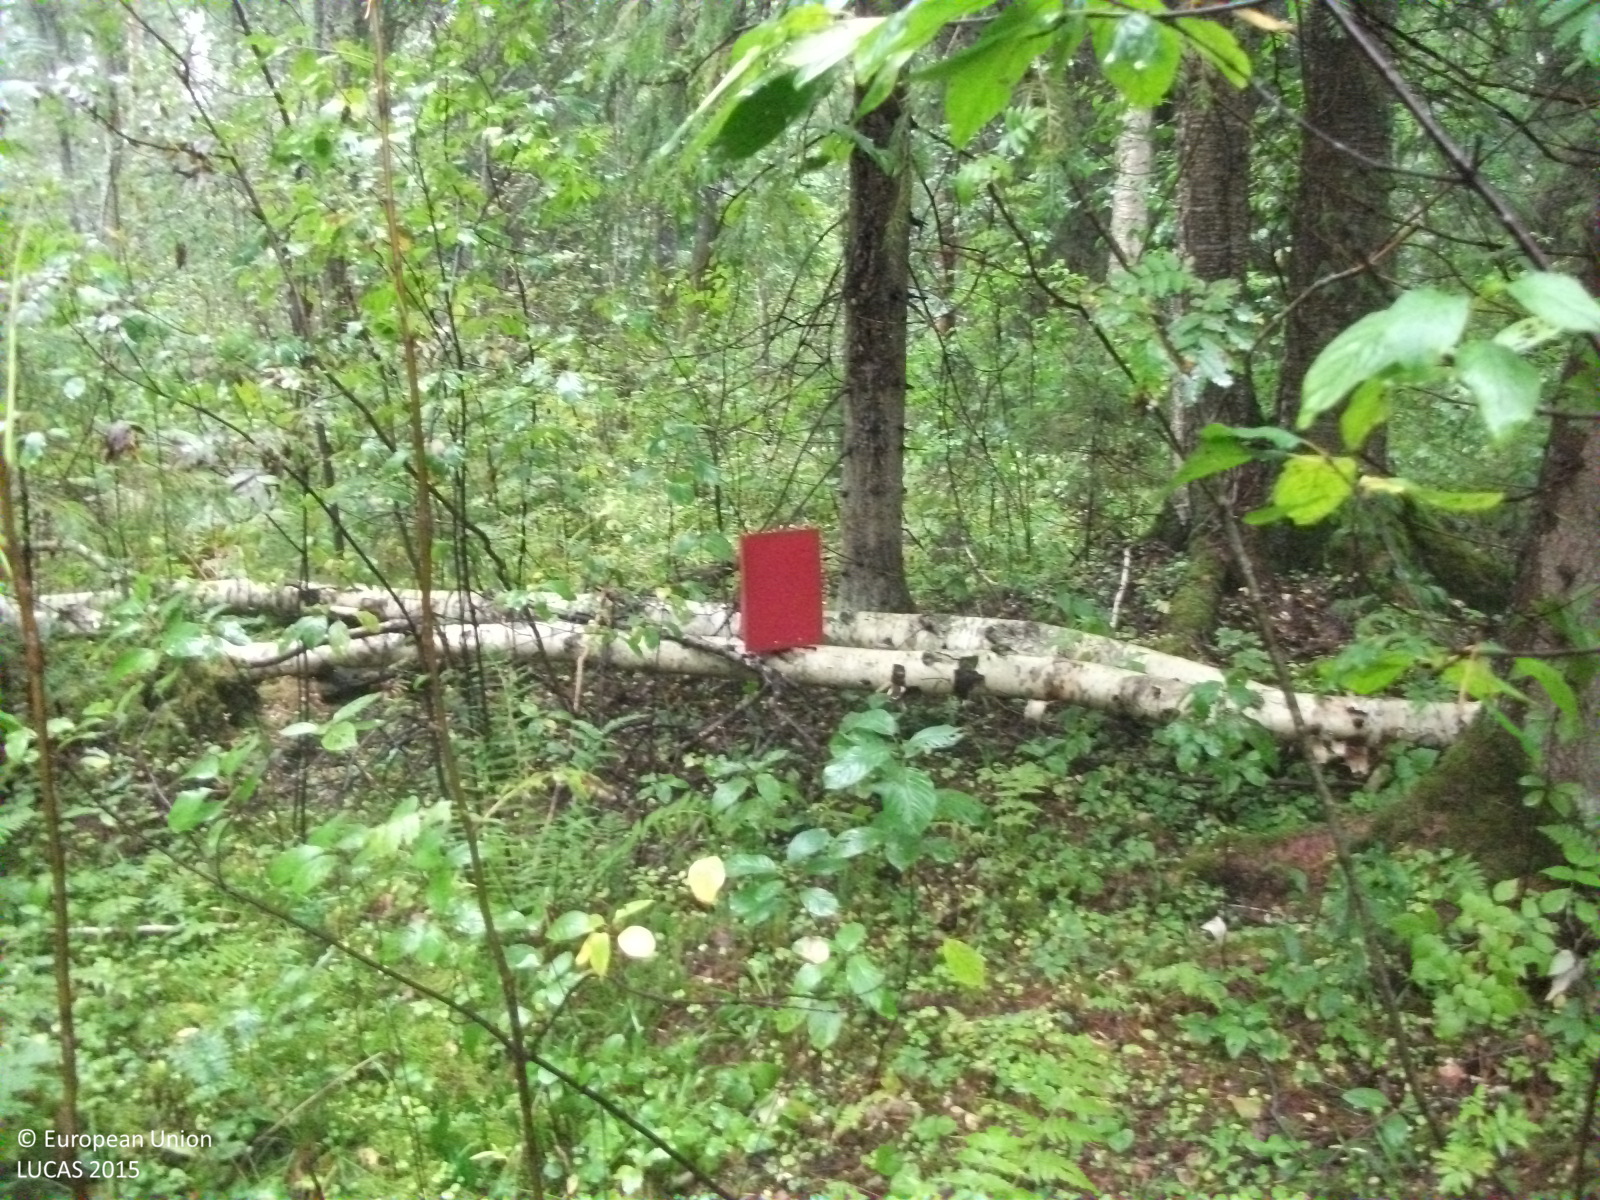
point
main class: Woodland
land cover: Spruce dominated mixed woodland
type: hemiboreal forest and nemoral coniferous forest and mixed broadleaved-coniferous forest
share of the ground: > 75 %
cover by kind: coniferous forest trees 55 %, broadleaved forest trees 30 %, herbaceous plants 10 %, shrubs 5 %
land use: Forestry
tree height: > 5 m
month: September
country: LV
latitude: 56.5975
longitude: 26.0804
